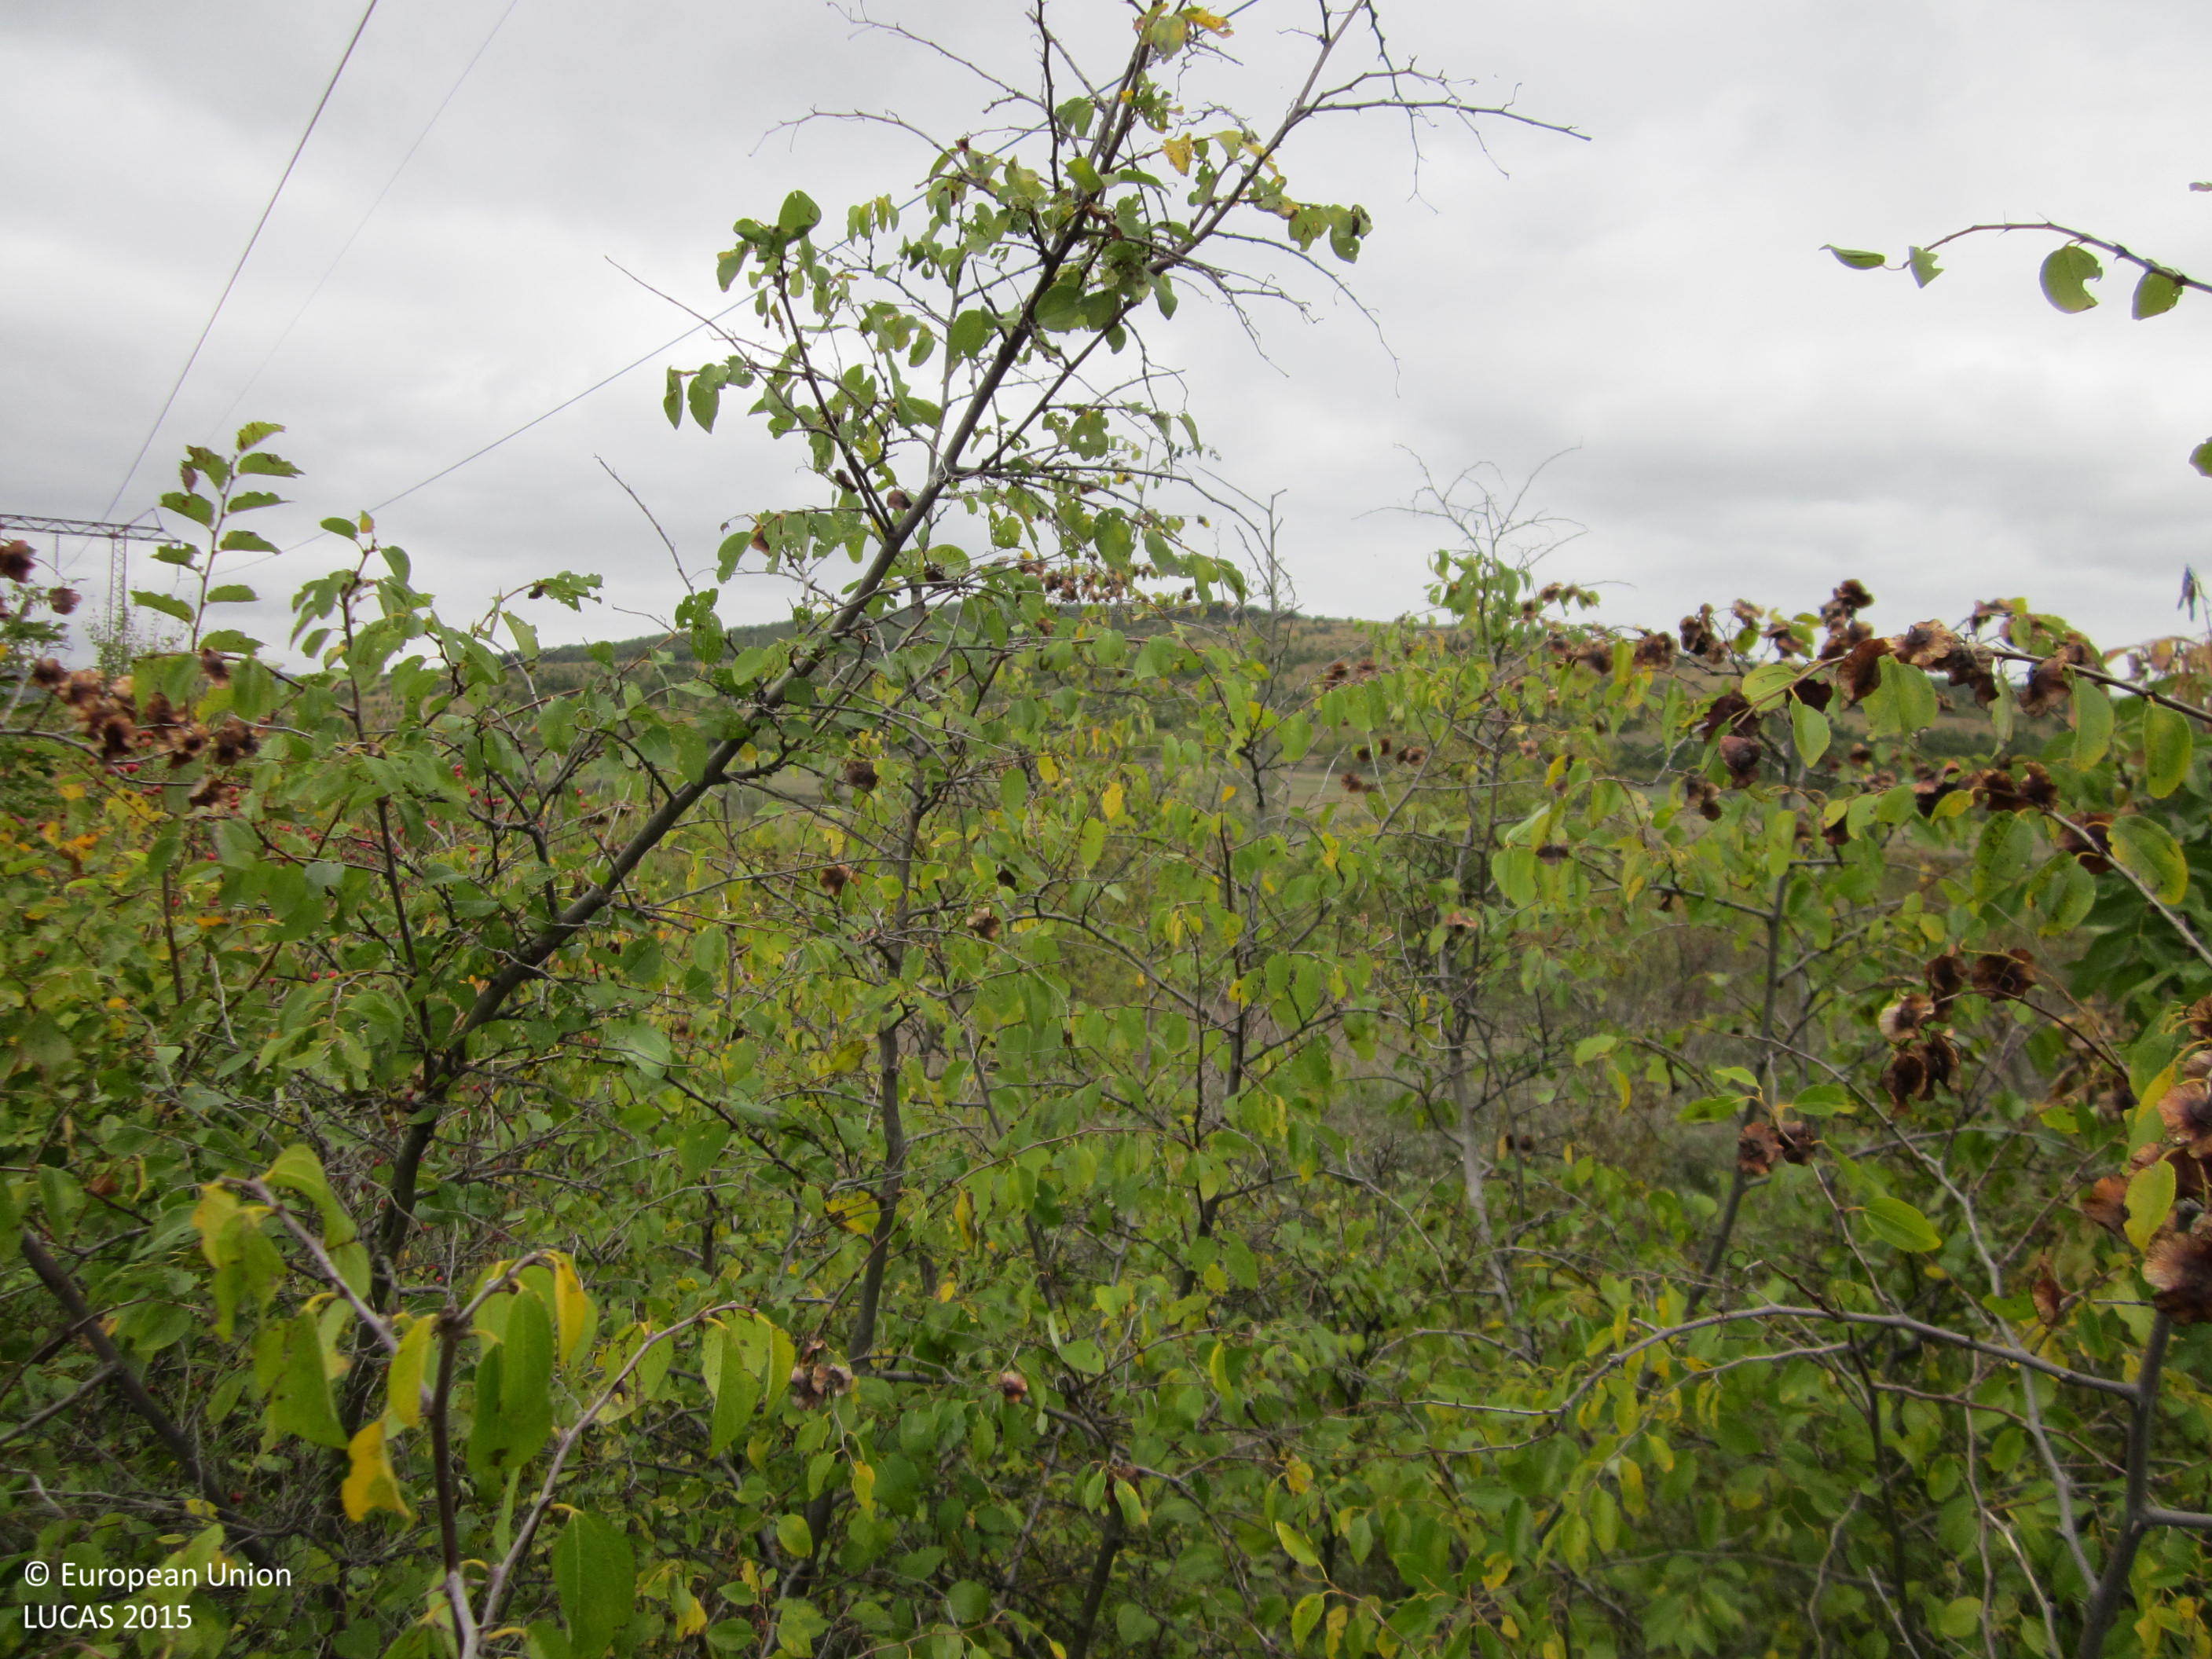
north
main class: Shrubland
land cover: Shrubland with sparse tree cover
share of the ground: > 75 %
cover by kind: shrubs 90 %, broadleaved forest trees 5 %, herbaceous plants 5 %
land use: Semi-natural and natural areas not in use
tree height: > 5 m
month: October
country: BG
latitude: 42.7422
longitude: 27.0525
